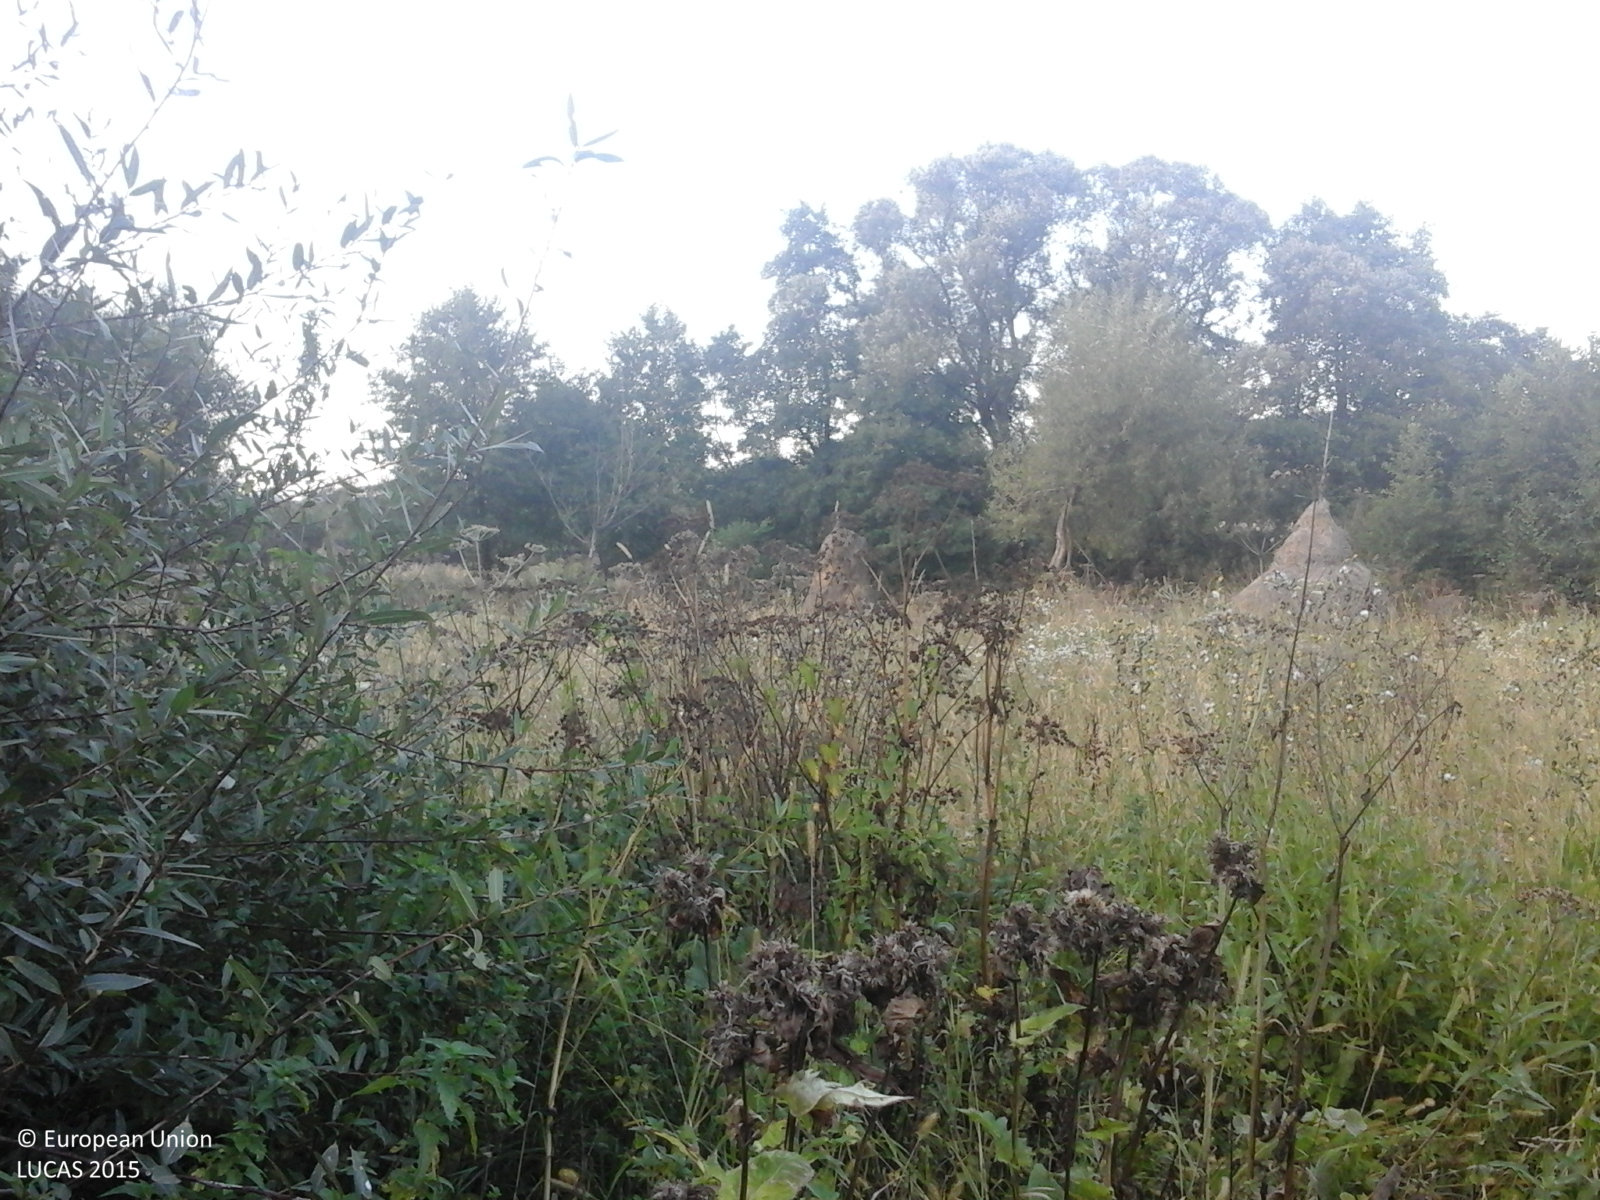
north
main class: Shrubland
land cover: Shrubland with sparse tree cover
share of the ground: > 75 %
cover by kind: shrubs 95 %, broadleaved forest trees 5 %
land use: Semi-natural and natural areas not in use
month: September
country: RO
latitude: 45.1626
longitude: 22.3172
